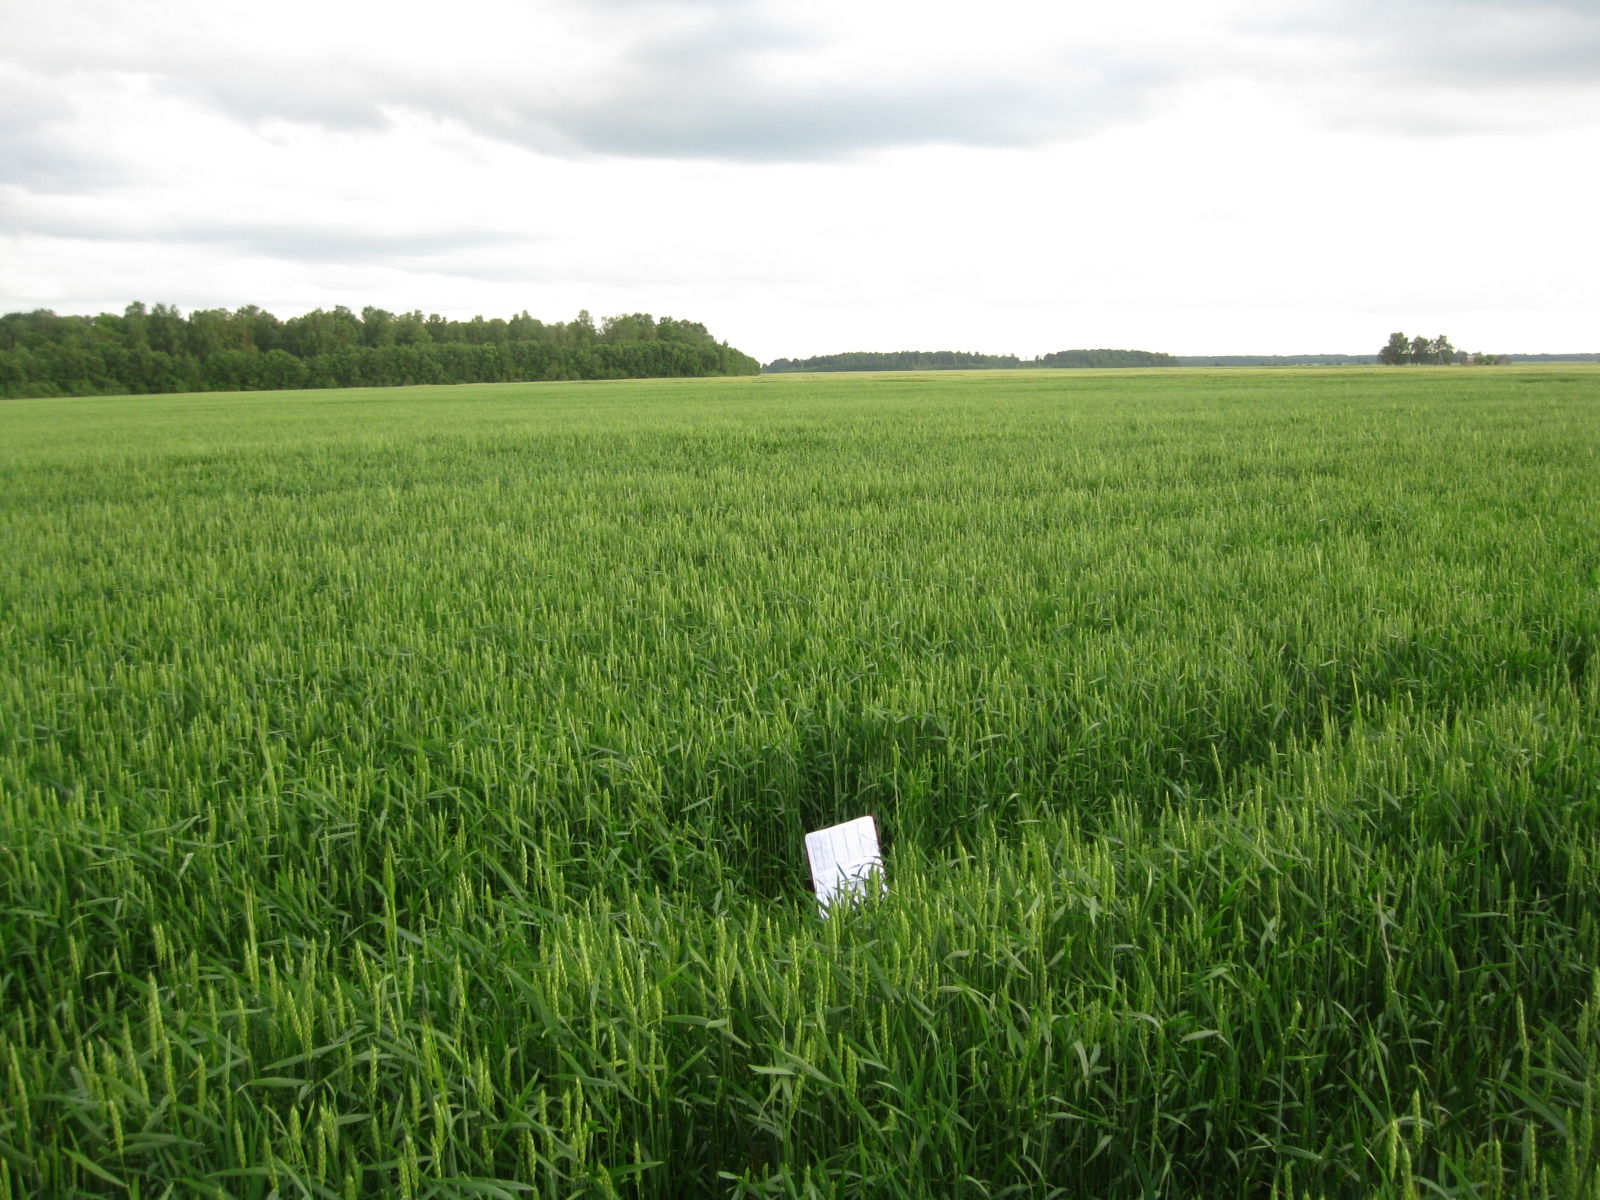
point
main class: Cropland
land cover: Common wheat
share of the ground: > 75 %
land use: Agriculture (excluding fallow land and kitchen gardens)
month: June
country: LT
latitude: 55.4671
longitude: 24.1866
